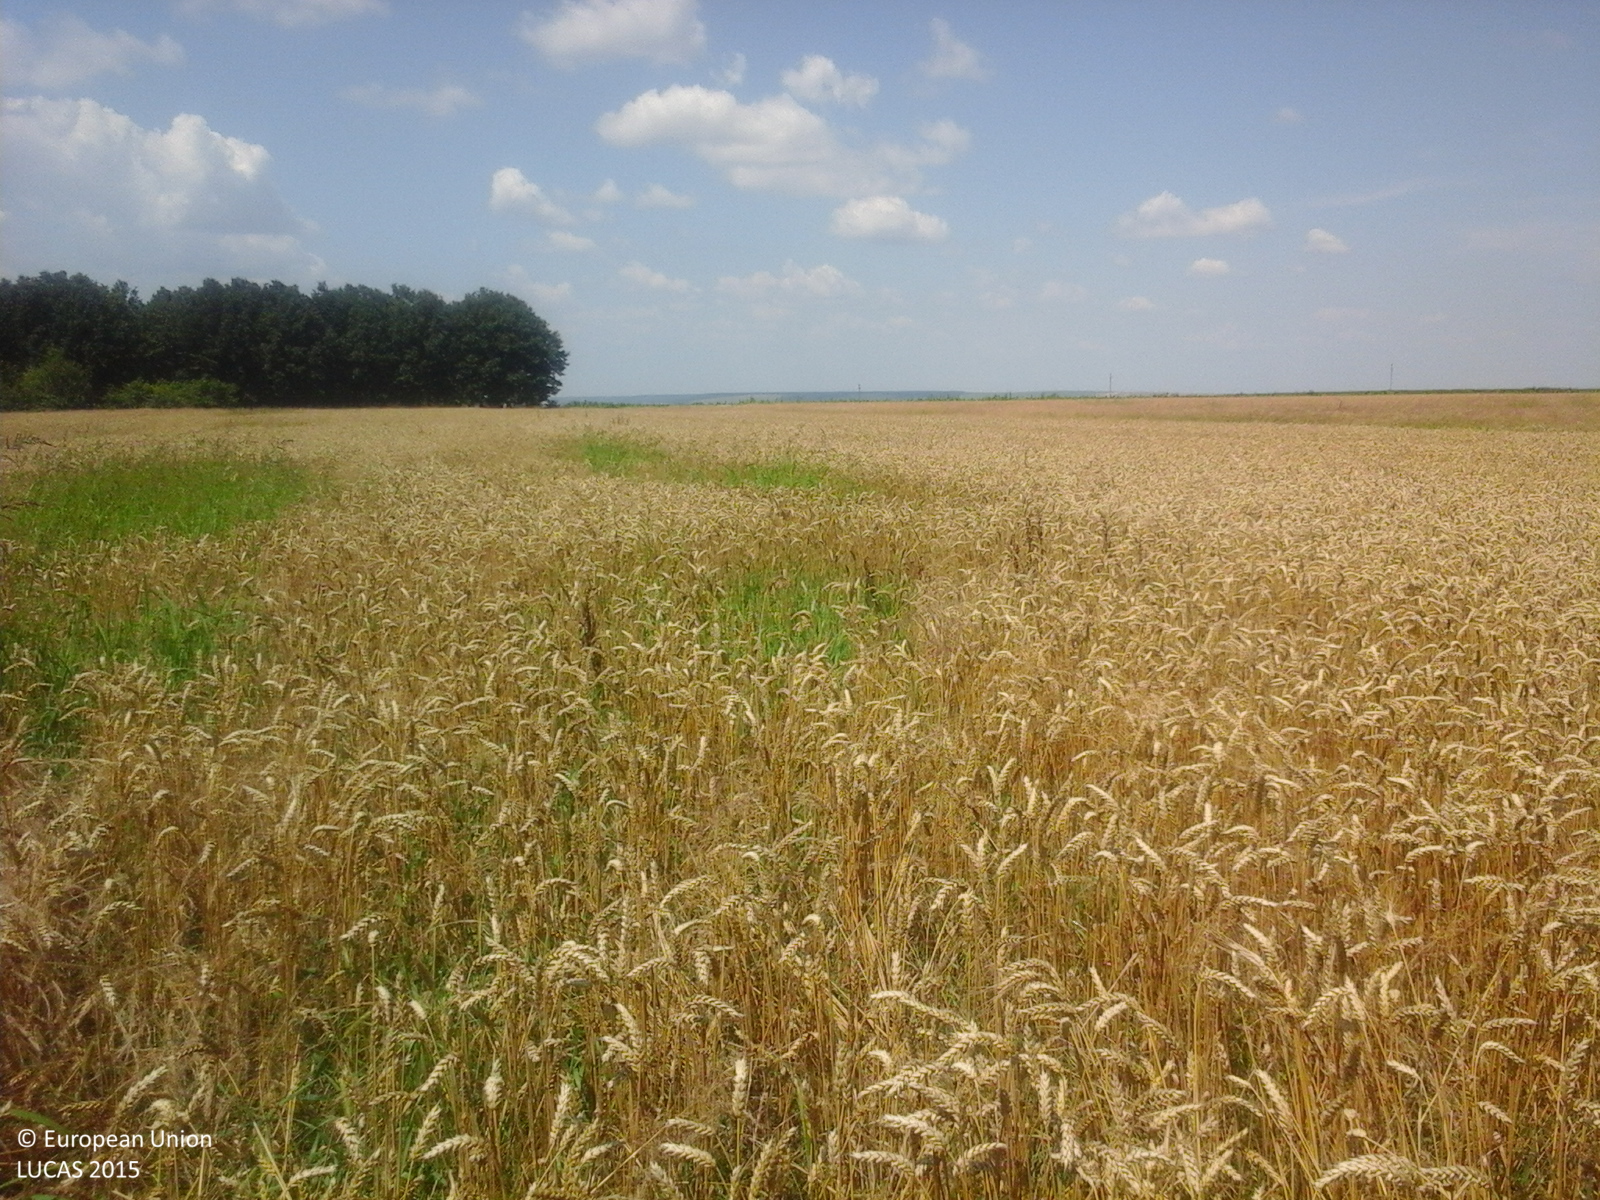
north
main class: Cropland
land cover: Common wheat
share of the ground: > 75 %
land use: Agriculture (excluding fallow land and kitchen gardens)
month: July
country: RO
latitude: 44.2670
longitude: 24.1812
